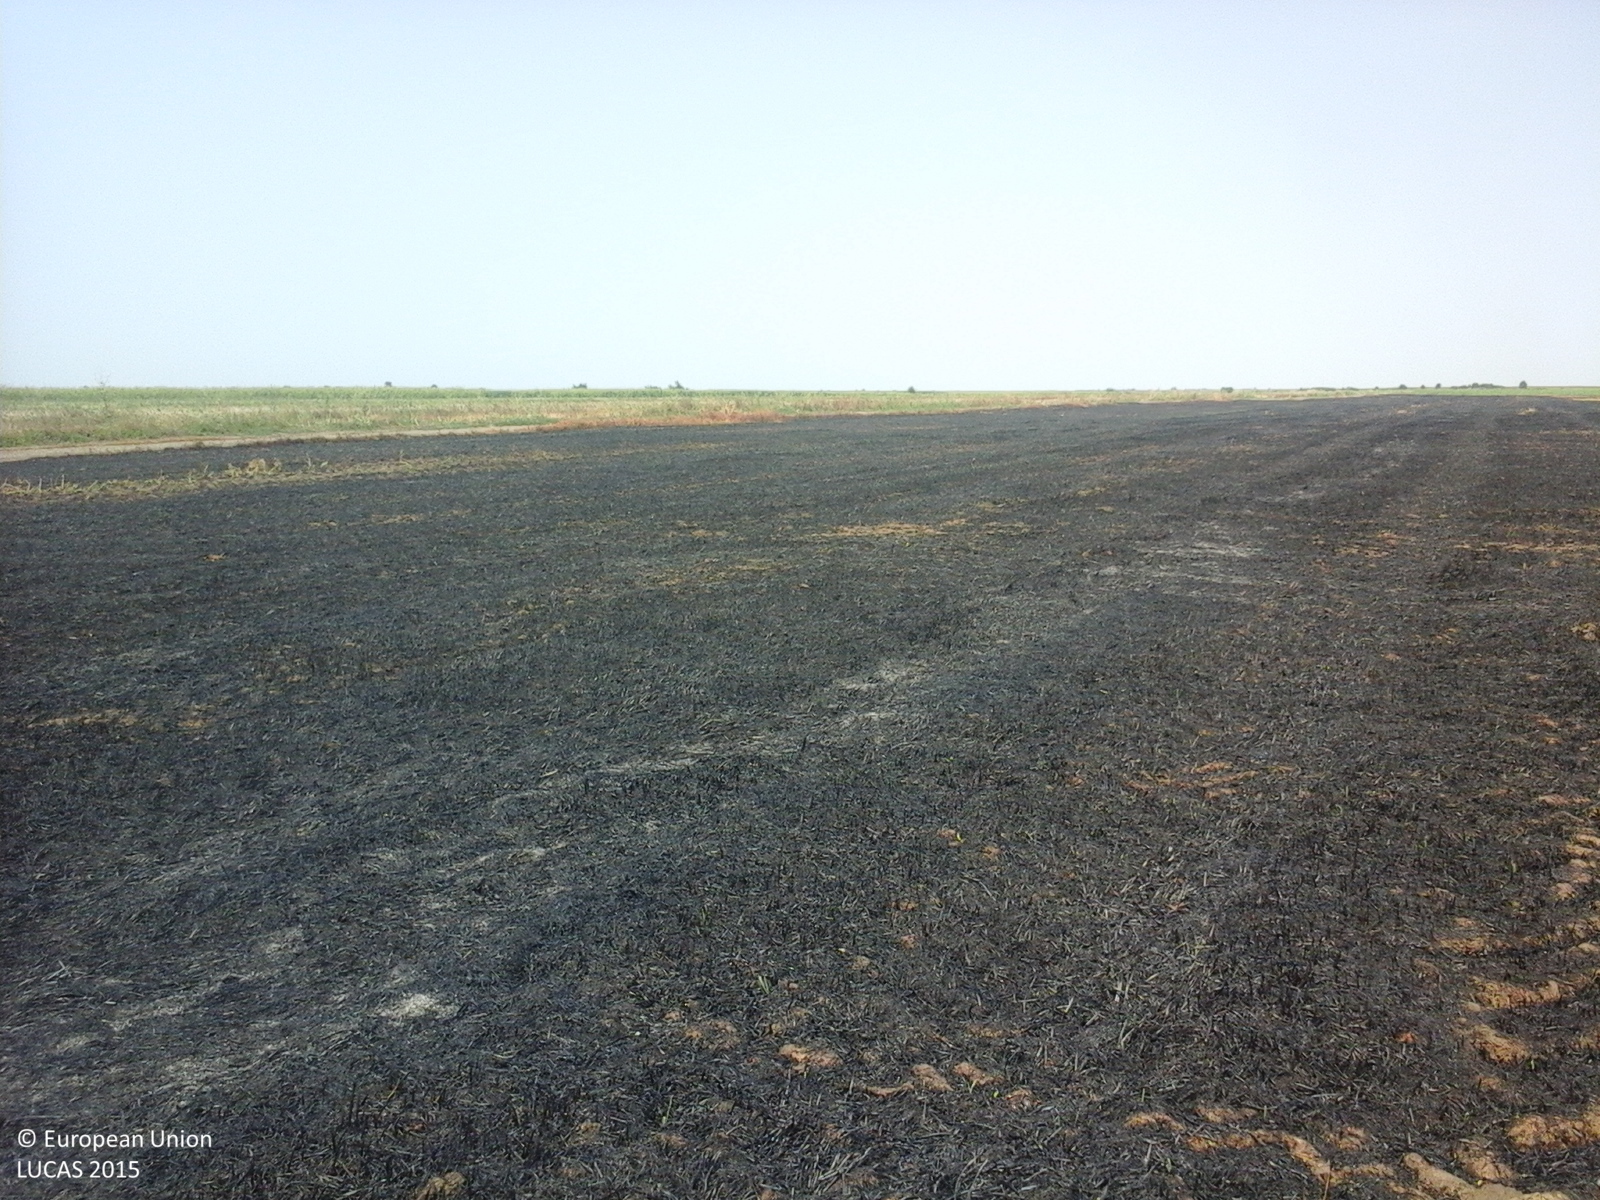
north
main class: Cropland
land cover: Common wheat
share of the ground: < 10 %
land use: Agriculture (excluding fallow land and kitchen gardens)
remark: Burnt area
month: July
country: RO
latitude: 44.5781
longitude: 26.6303
